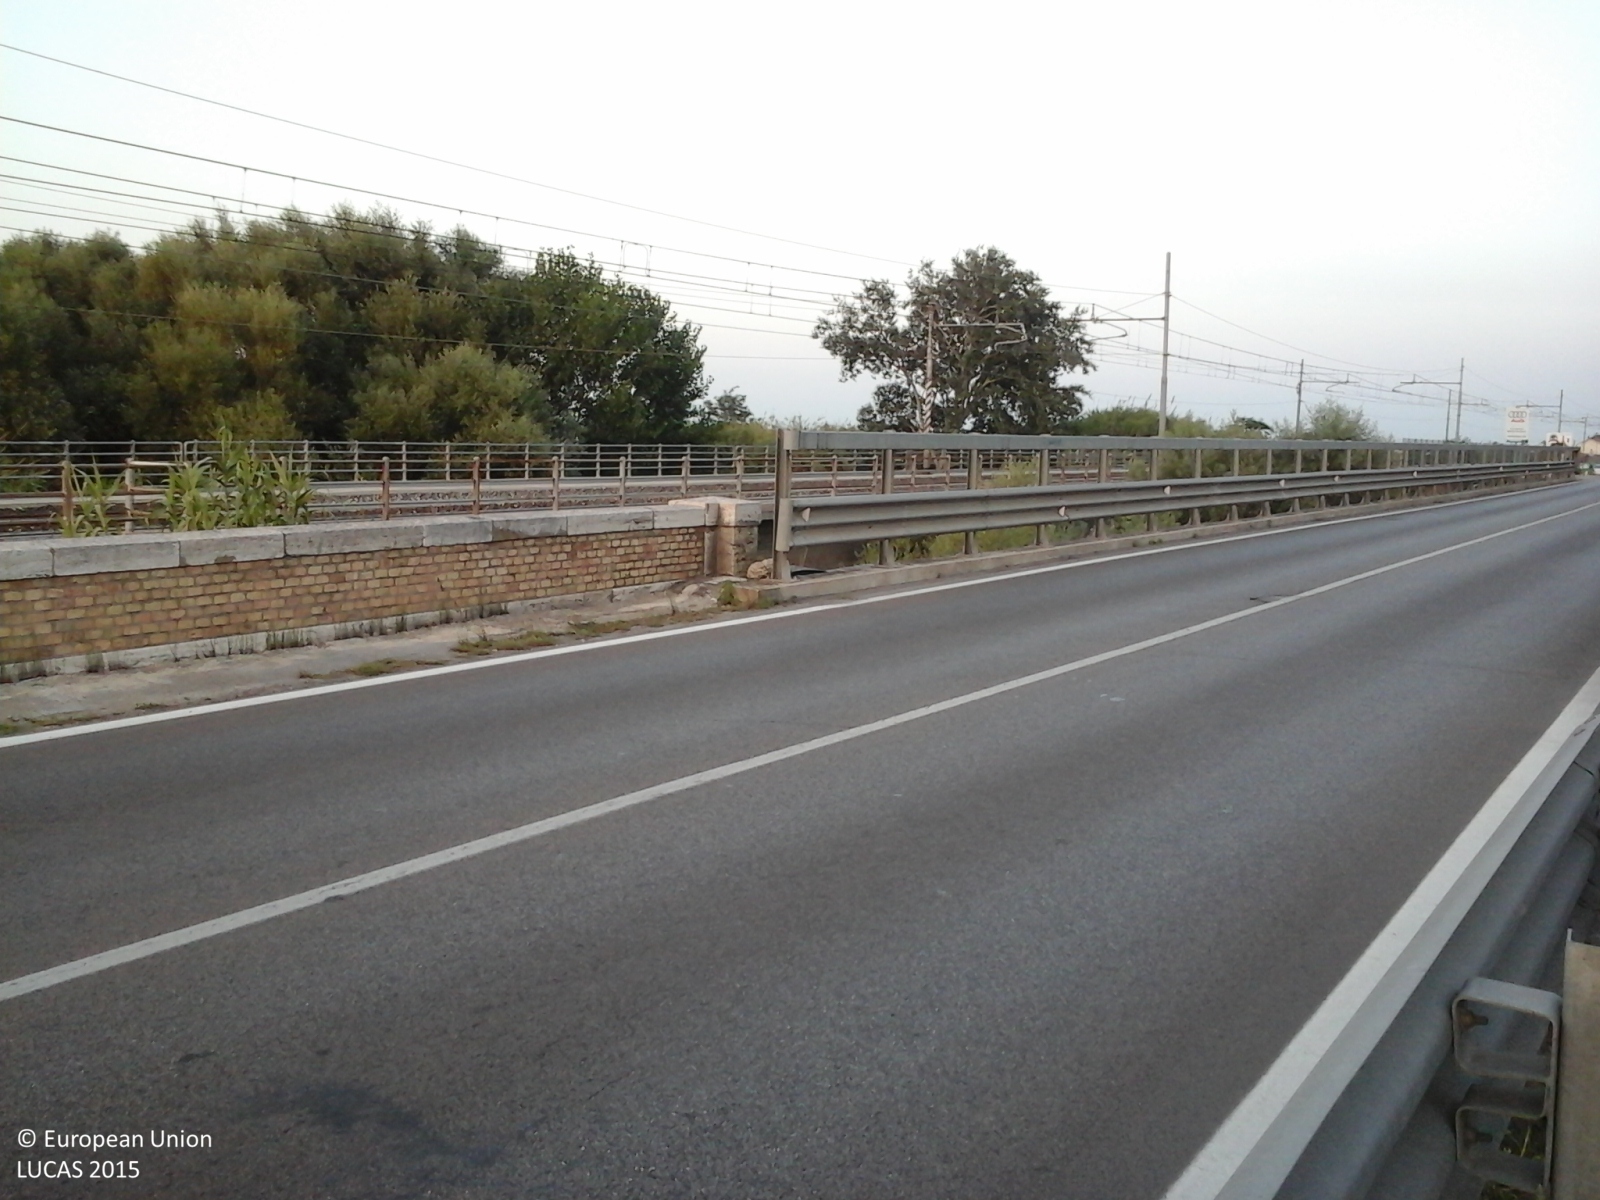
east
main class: Grassland
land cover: Grassland without tree/shrub cover
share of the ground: > 75 %
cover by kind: herbaceous plants 100 %
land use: Agriculture (excluding fallow land and kitchen gardens)
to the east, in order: Grassland without tree/shrub cover; Broadleaved woodland; Rivers and streams; Broadleaved woodland; Artificial constructions in urban areas; Grassland without tree/shrub cover; Single bushes/trees; Artificial constructions in urban areas; Single bushes/trees; Grassland without tree/shrub cover; Fences; Single bushes/trees; Paved roads, cycling and walking lanes
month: July
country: IT
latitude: 42.3989
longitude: 14.3244
